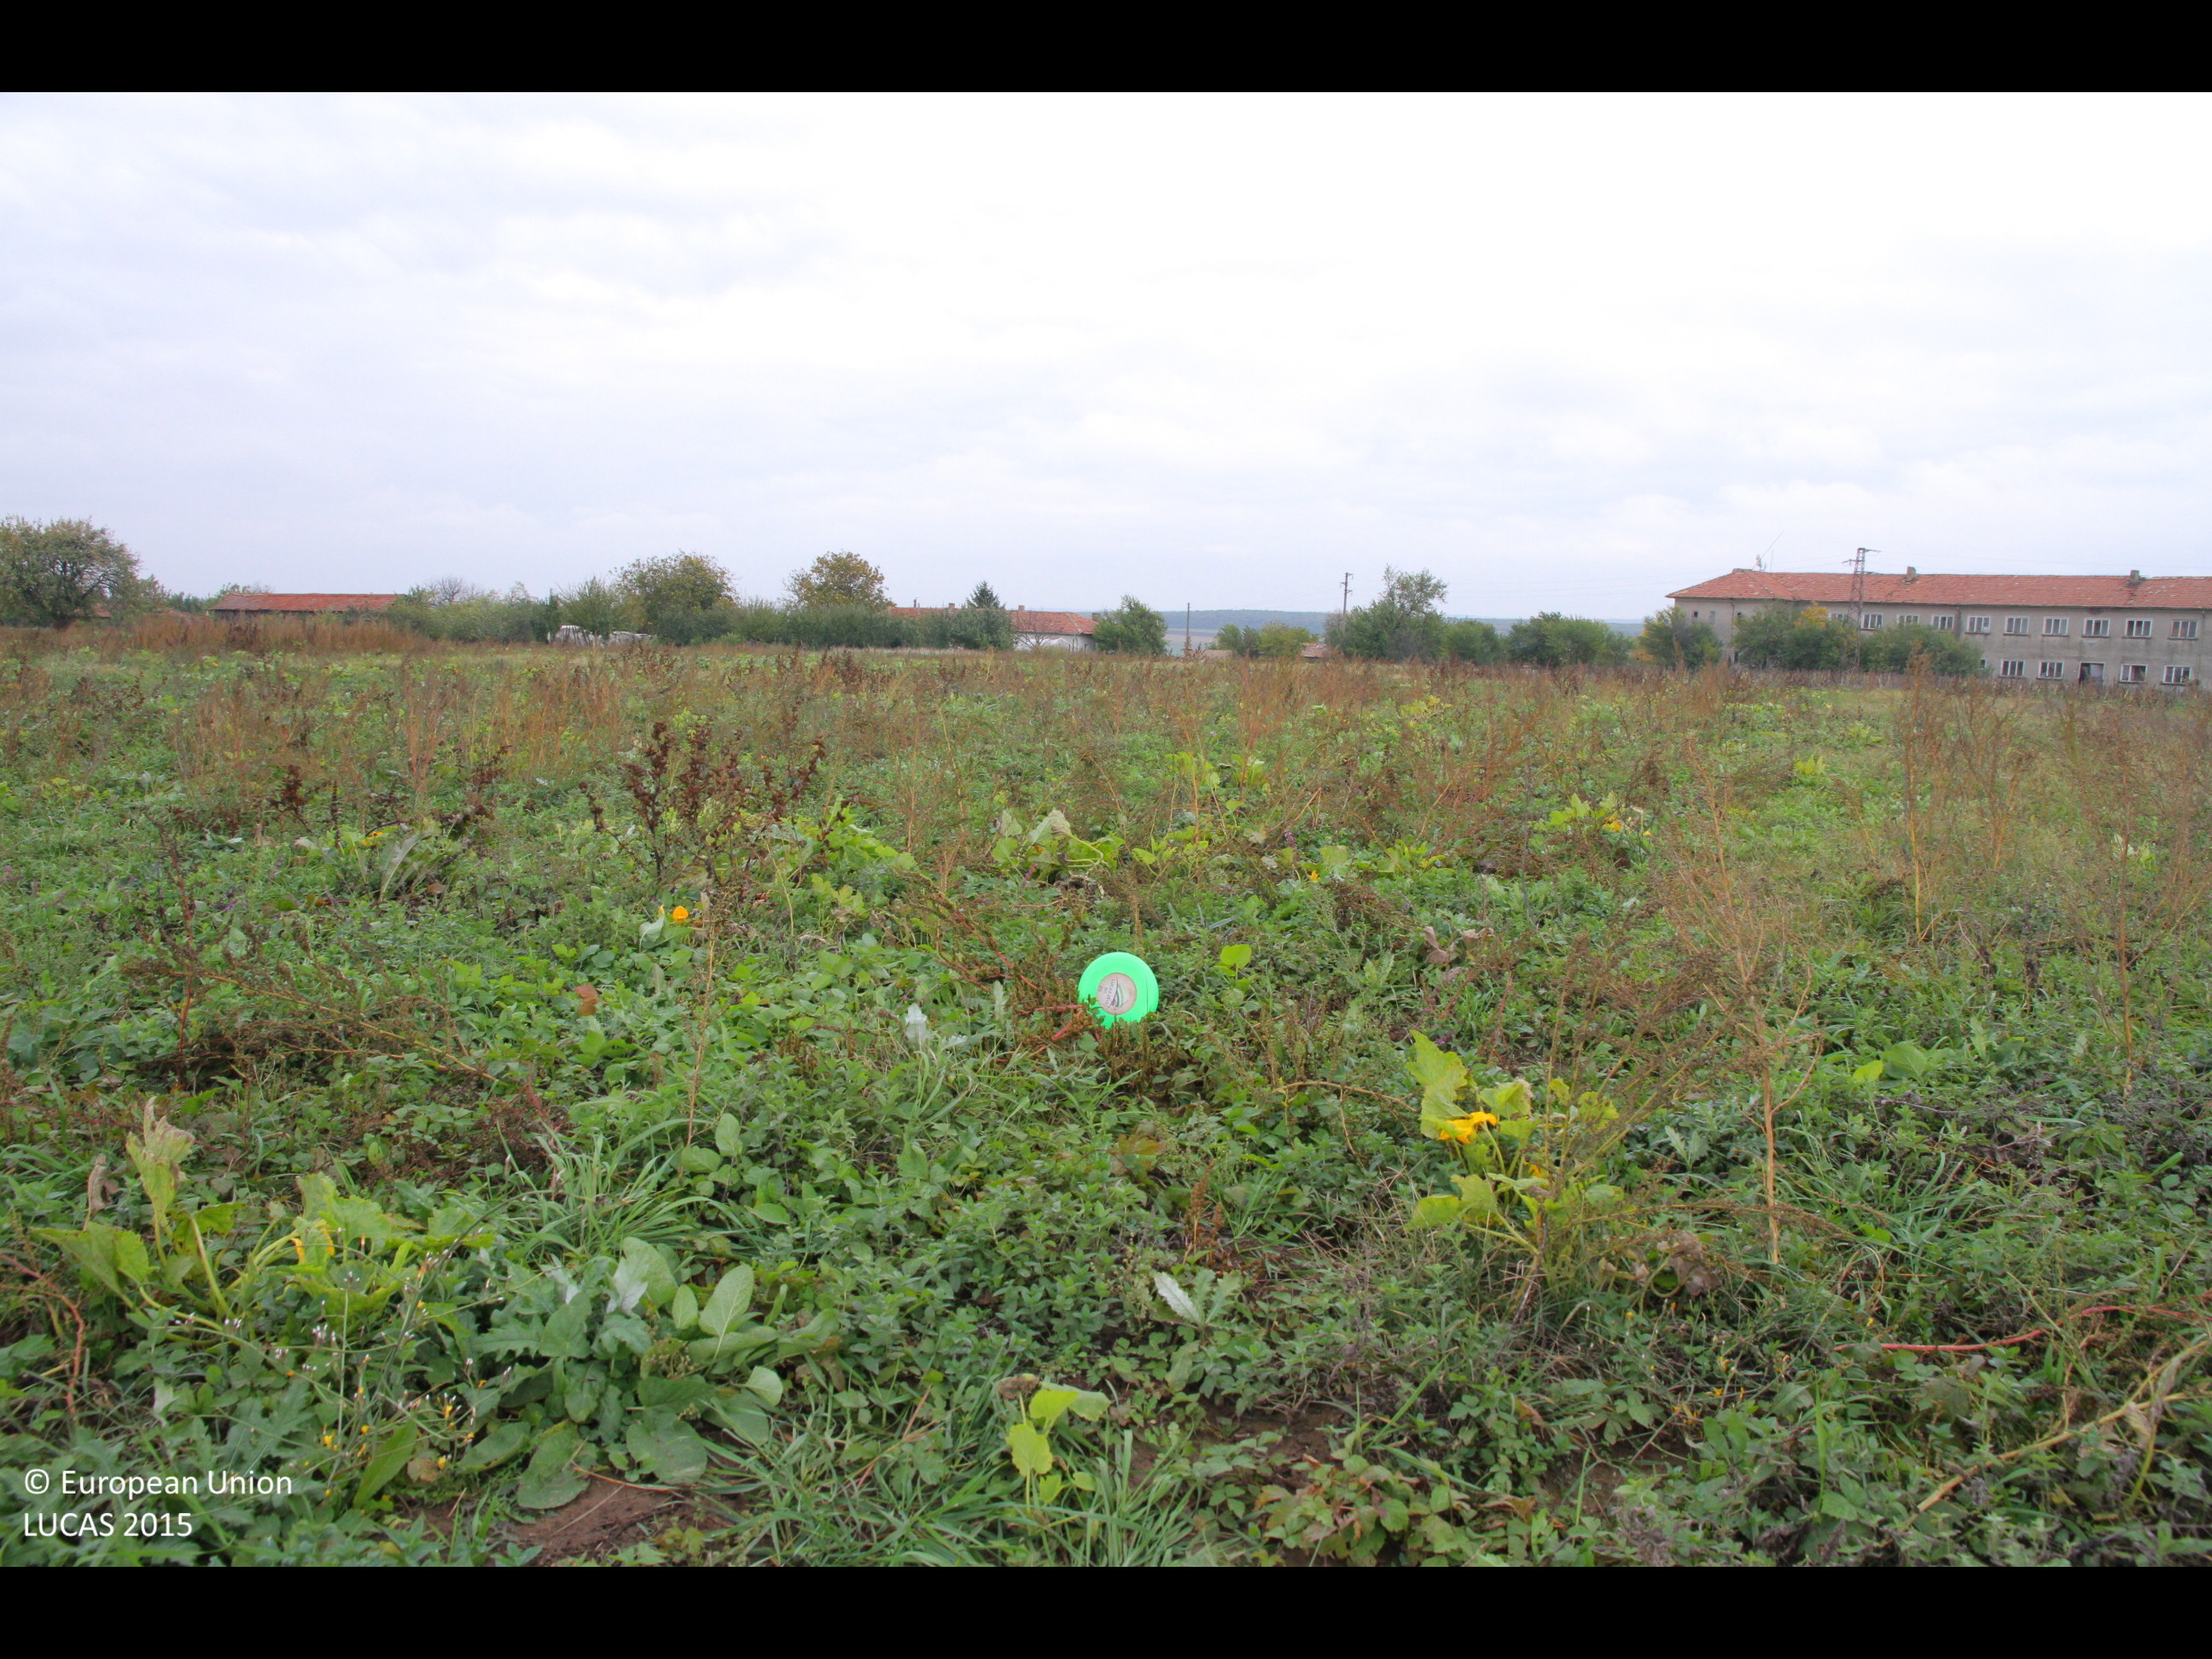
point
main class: Cropland
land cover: Other fresh vegetables
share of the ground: 10 - 25 %
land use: Agriculture (excluding fallow land and kitchen gardens)
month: October
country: BG
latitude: 43.5434
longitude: 26.8849
